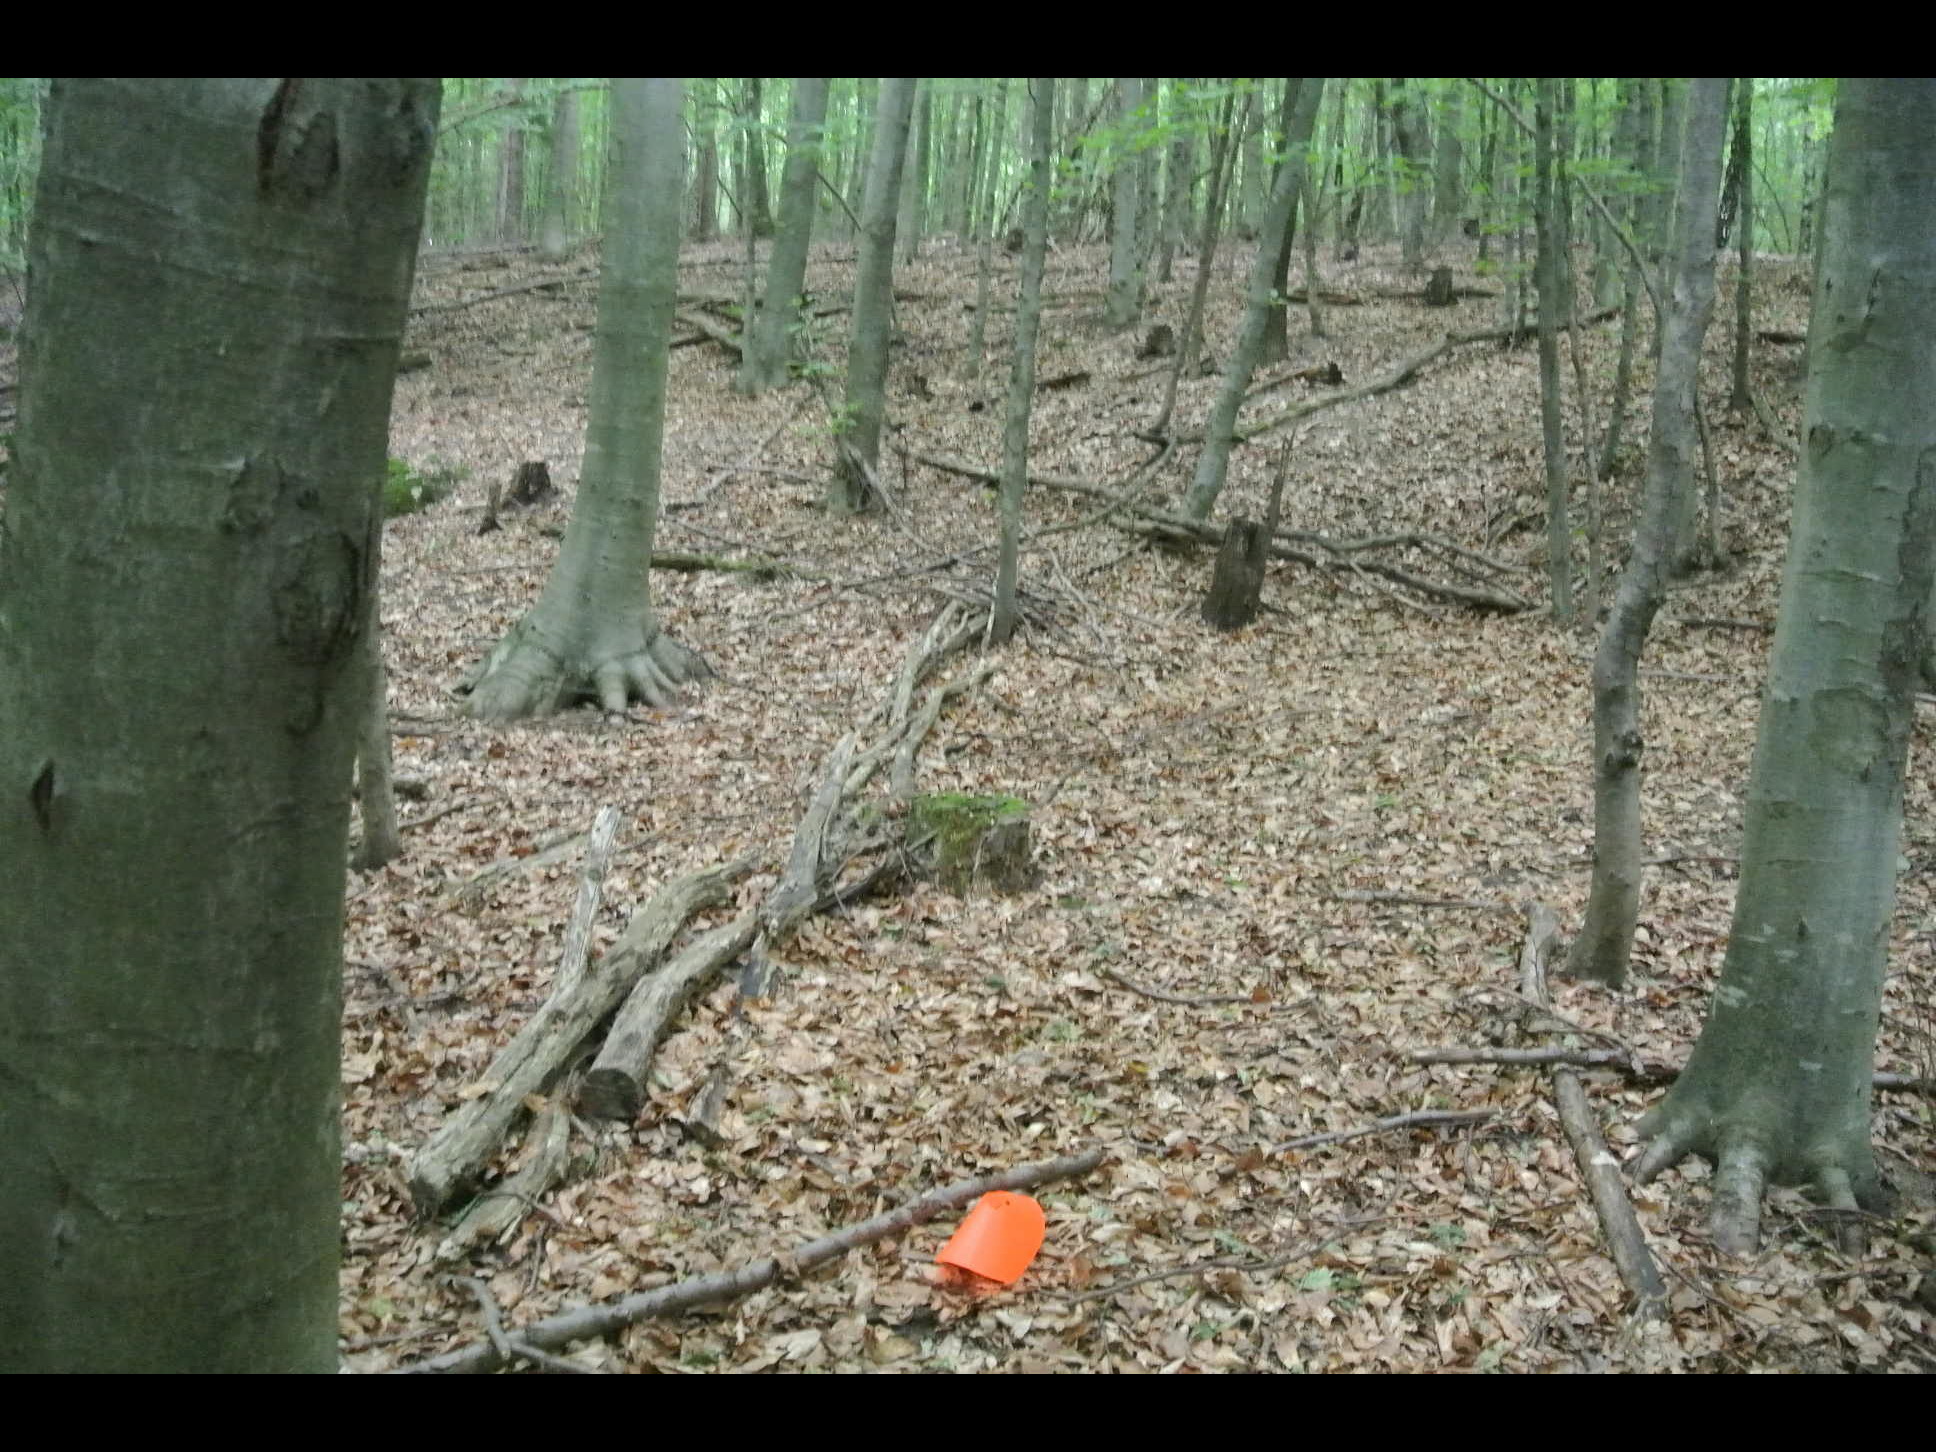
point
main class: Woodland
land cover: Broadleaved woodland
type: beech forest
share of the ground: > 75 %
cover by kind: broadleaved forest trees 100 %
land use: Forestry
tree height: > 5 m
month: July
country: AT
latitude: 47.6206
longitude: 16.4305
